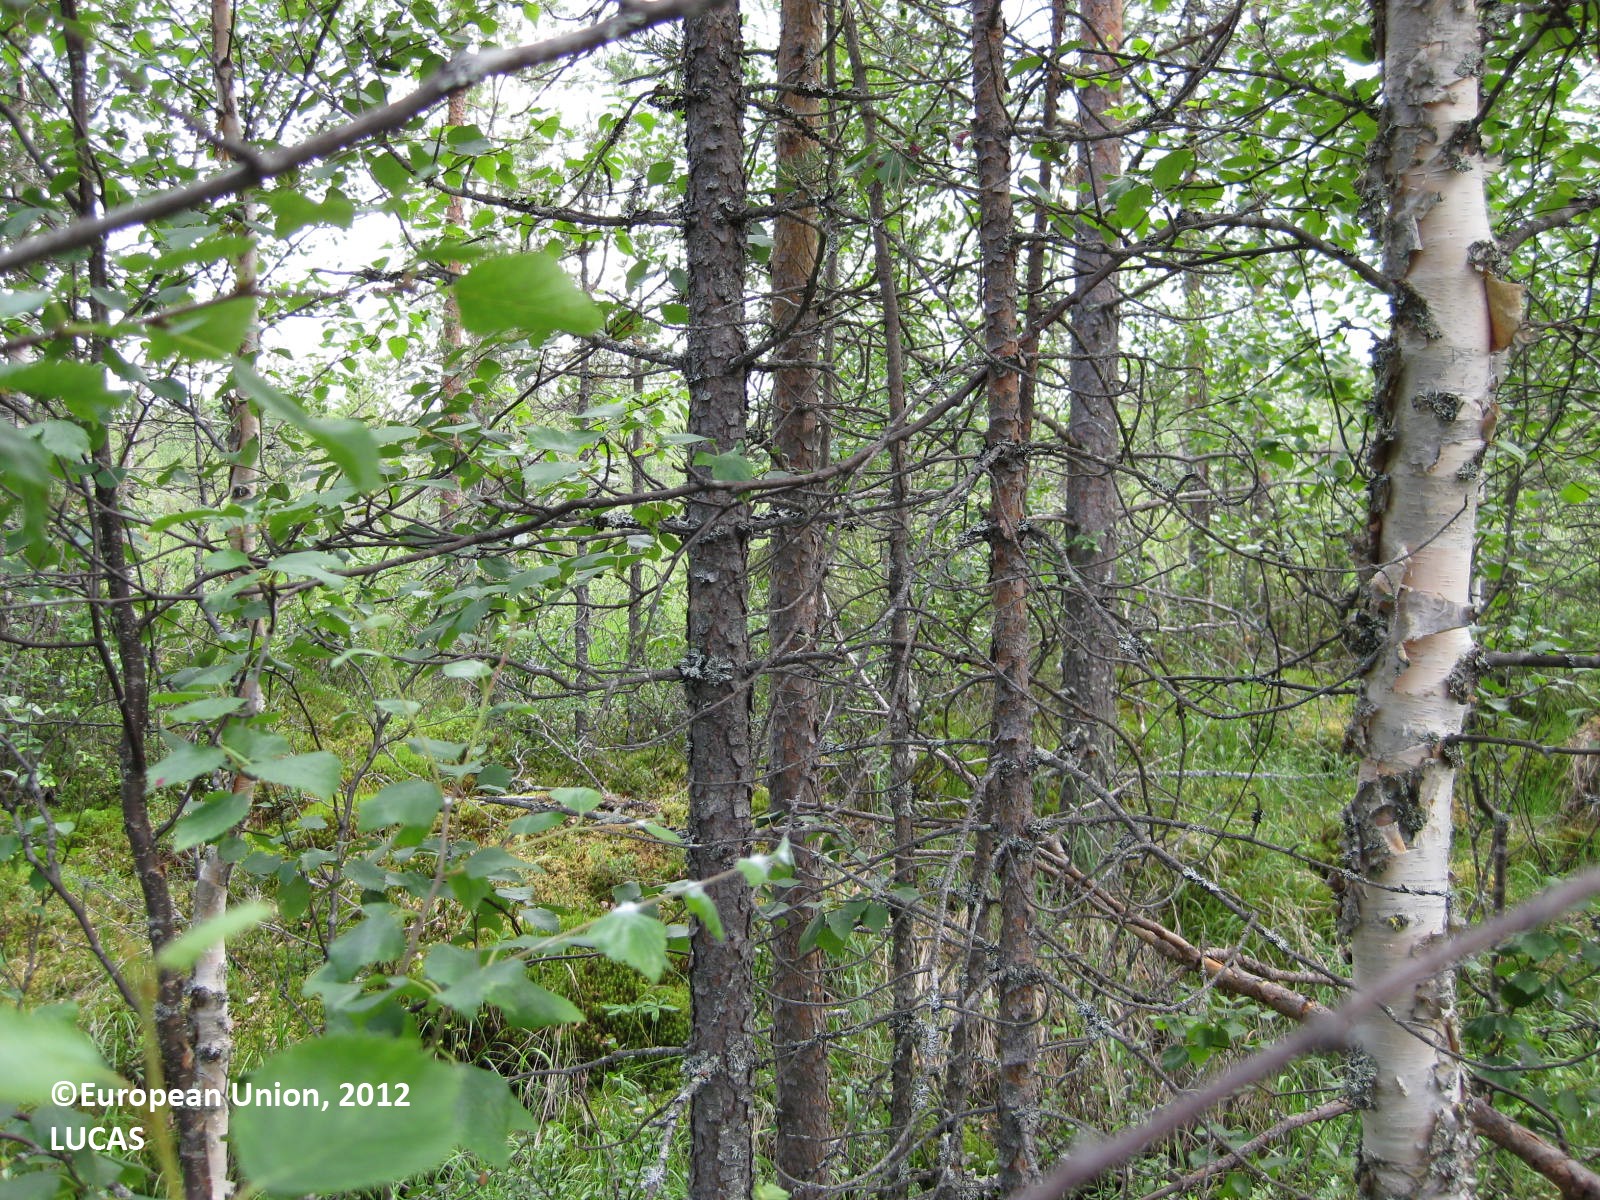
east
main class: Woodland
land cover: Pine dominated mixed woodland
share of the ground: > 75 %
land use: Forestry
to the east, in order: Pine dominated mixed woodland; Ditches and canals; Pine dominated mixed woodland; Pine dominated coniferous woodland; Ponds and wetlands; Pine dominated coniferous woodland; Inland marshes; Pine dominated mixed woodland; Ditches and canals; Pine dominated mixed woodland; Ditches and canals; Pine dominated mixed woodland; Ditches and canals; Shrubland with sparse tree cover; Abandoned hedges; Ditches and canals; Abandoned hedges; Spontaneously vegetated surfaces; Abandoned hedges; Ditches and canals; Spontaneously vegetated surfaces; Abandoned hedges; Ditches and canals; Abandoned hedges; Grassland with sparse tree/shrub cover
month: July
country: FI
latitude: 65.6678
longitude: 29.3073
